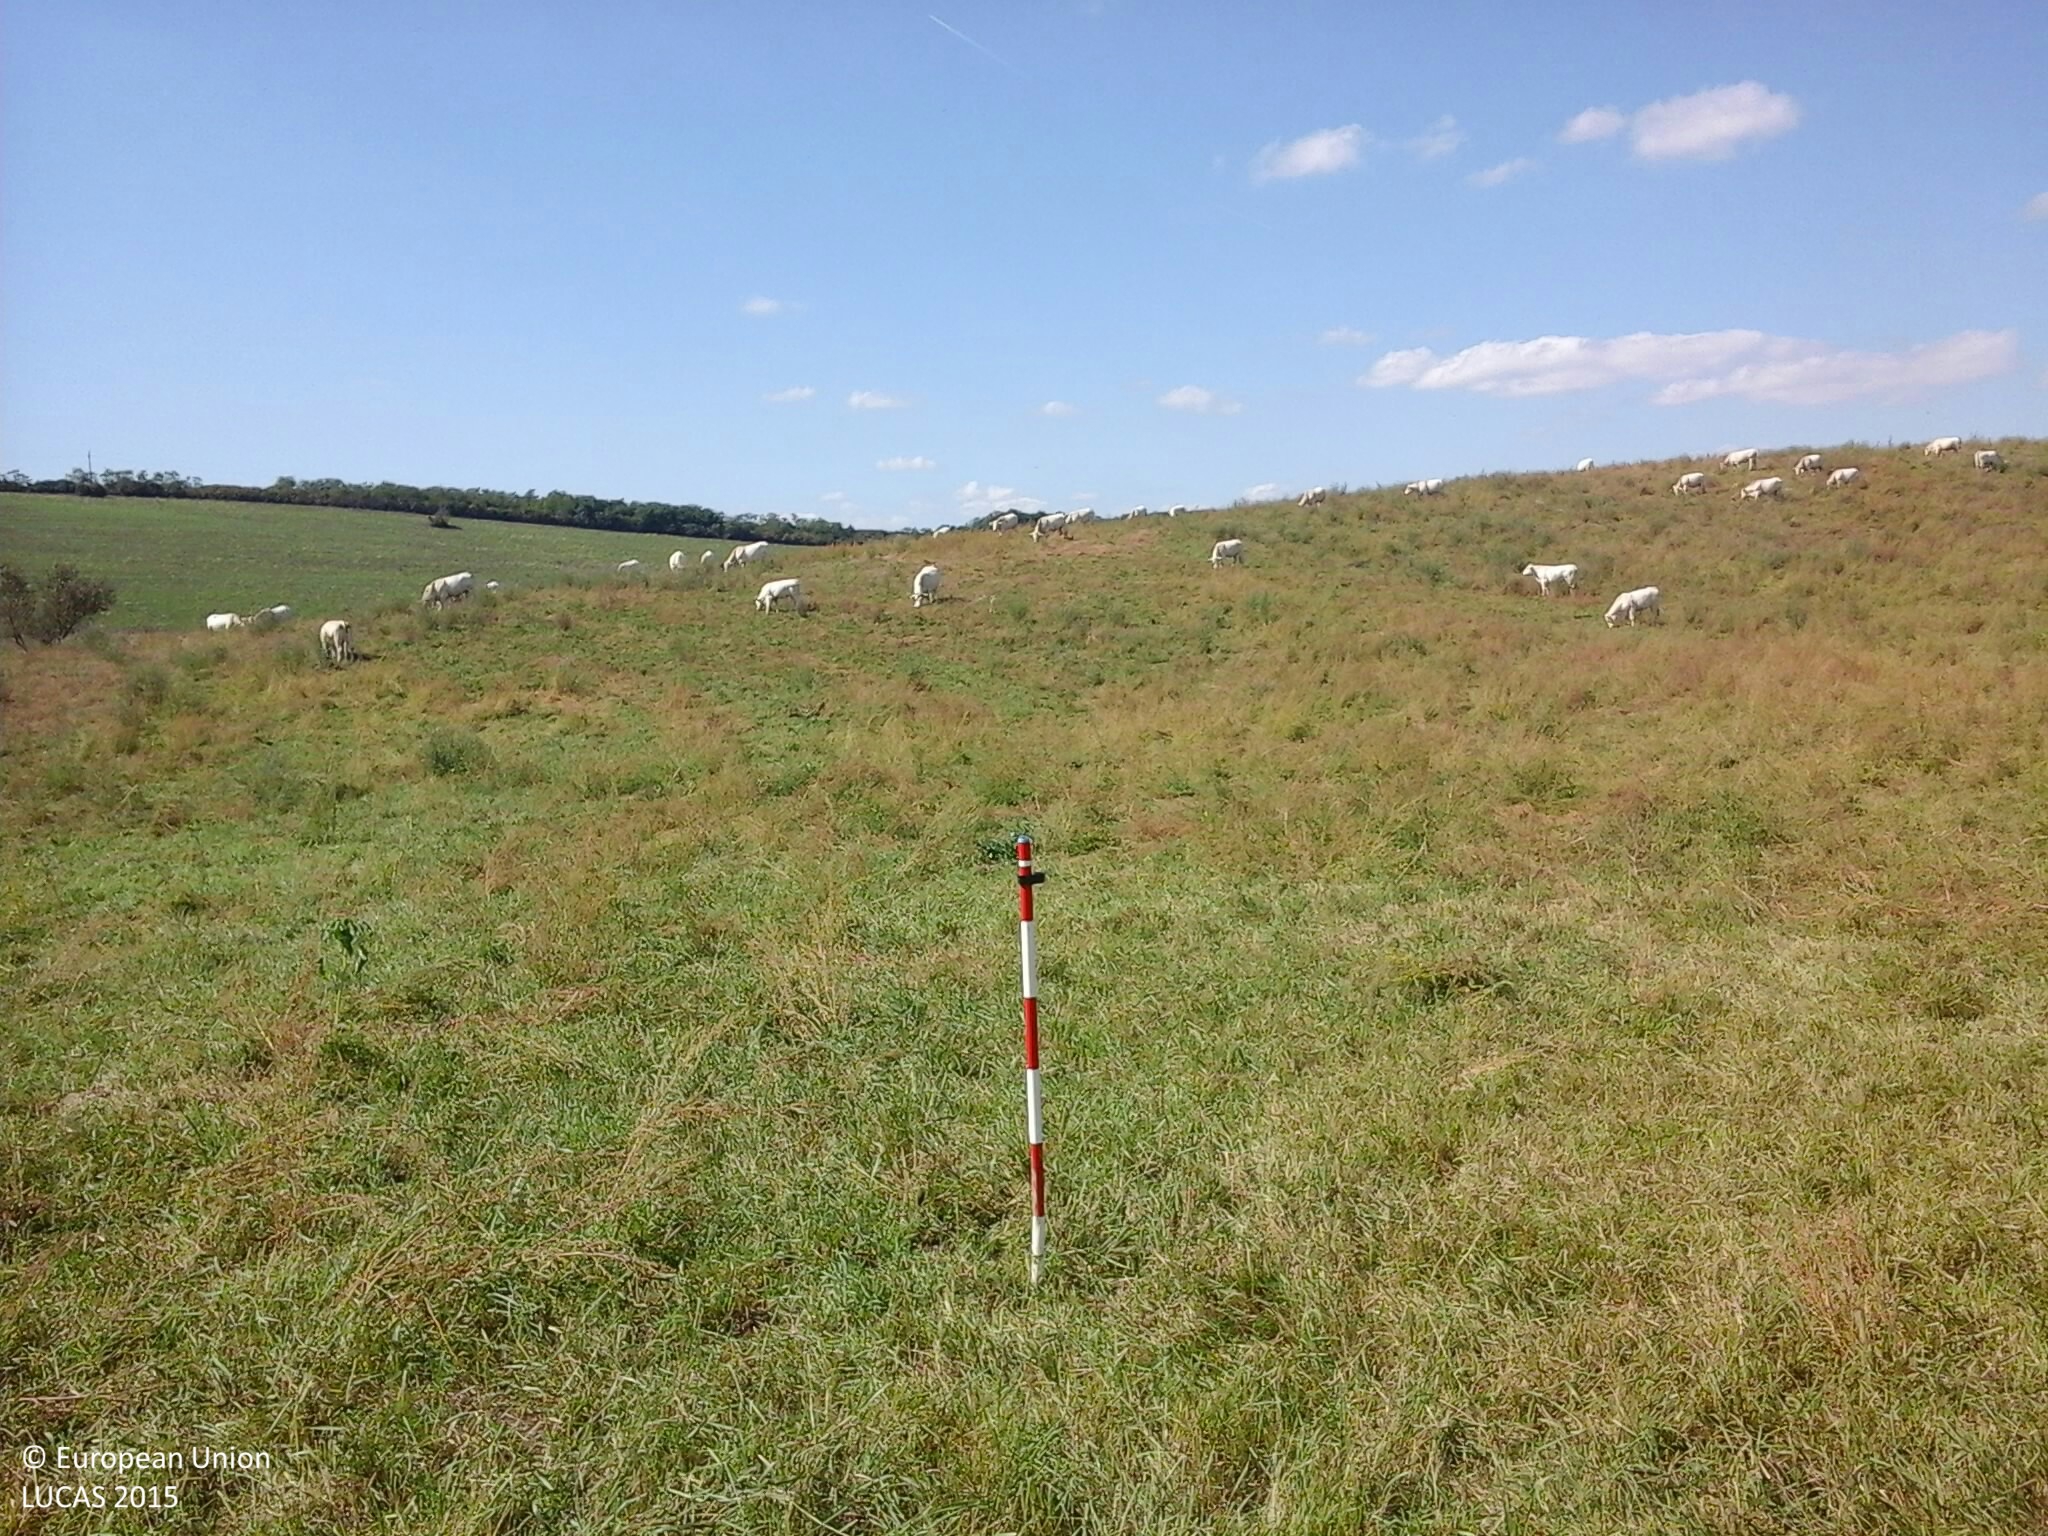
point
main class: Grassland
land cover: Grassland without tree/shrub cover
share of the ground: > 75 %
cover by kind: herbaceous plants 100 %
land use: Agriculture (excluding fallow land and kitchen gardens)
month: September
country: HU
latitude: 48.0369
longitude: 19.8307
